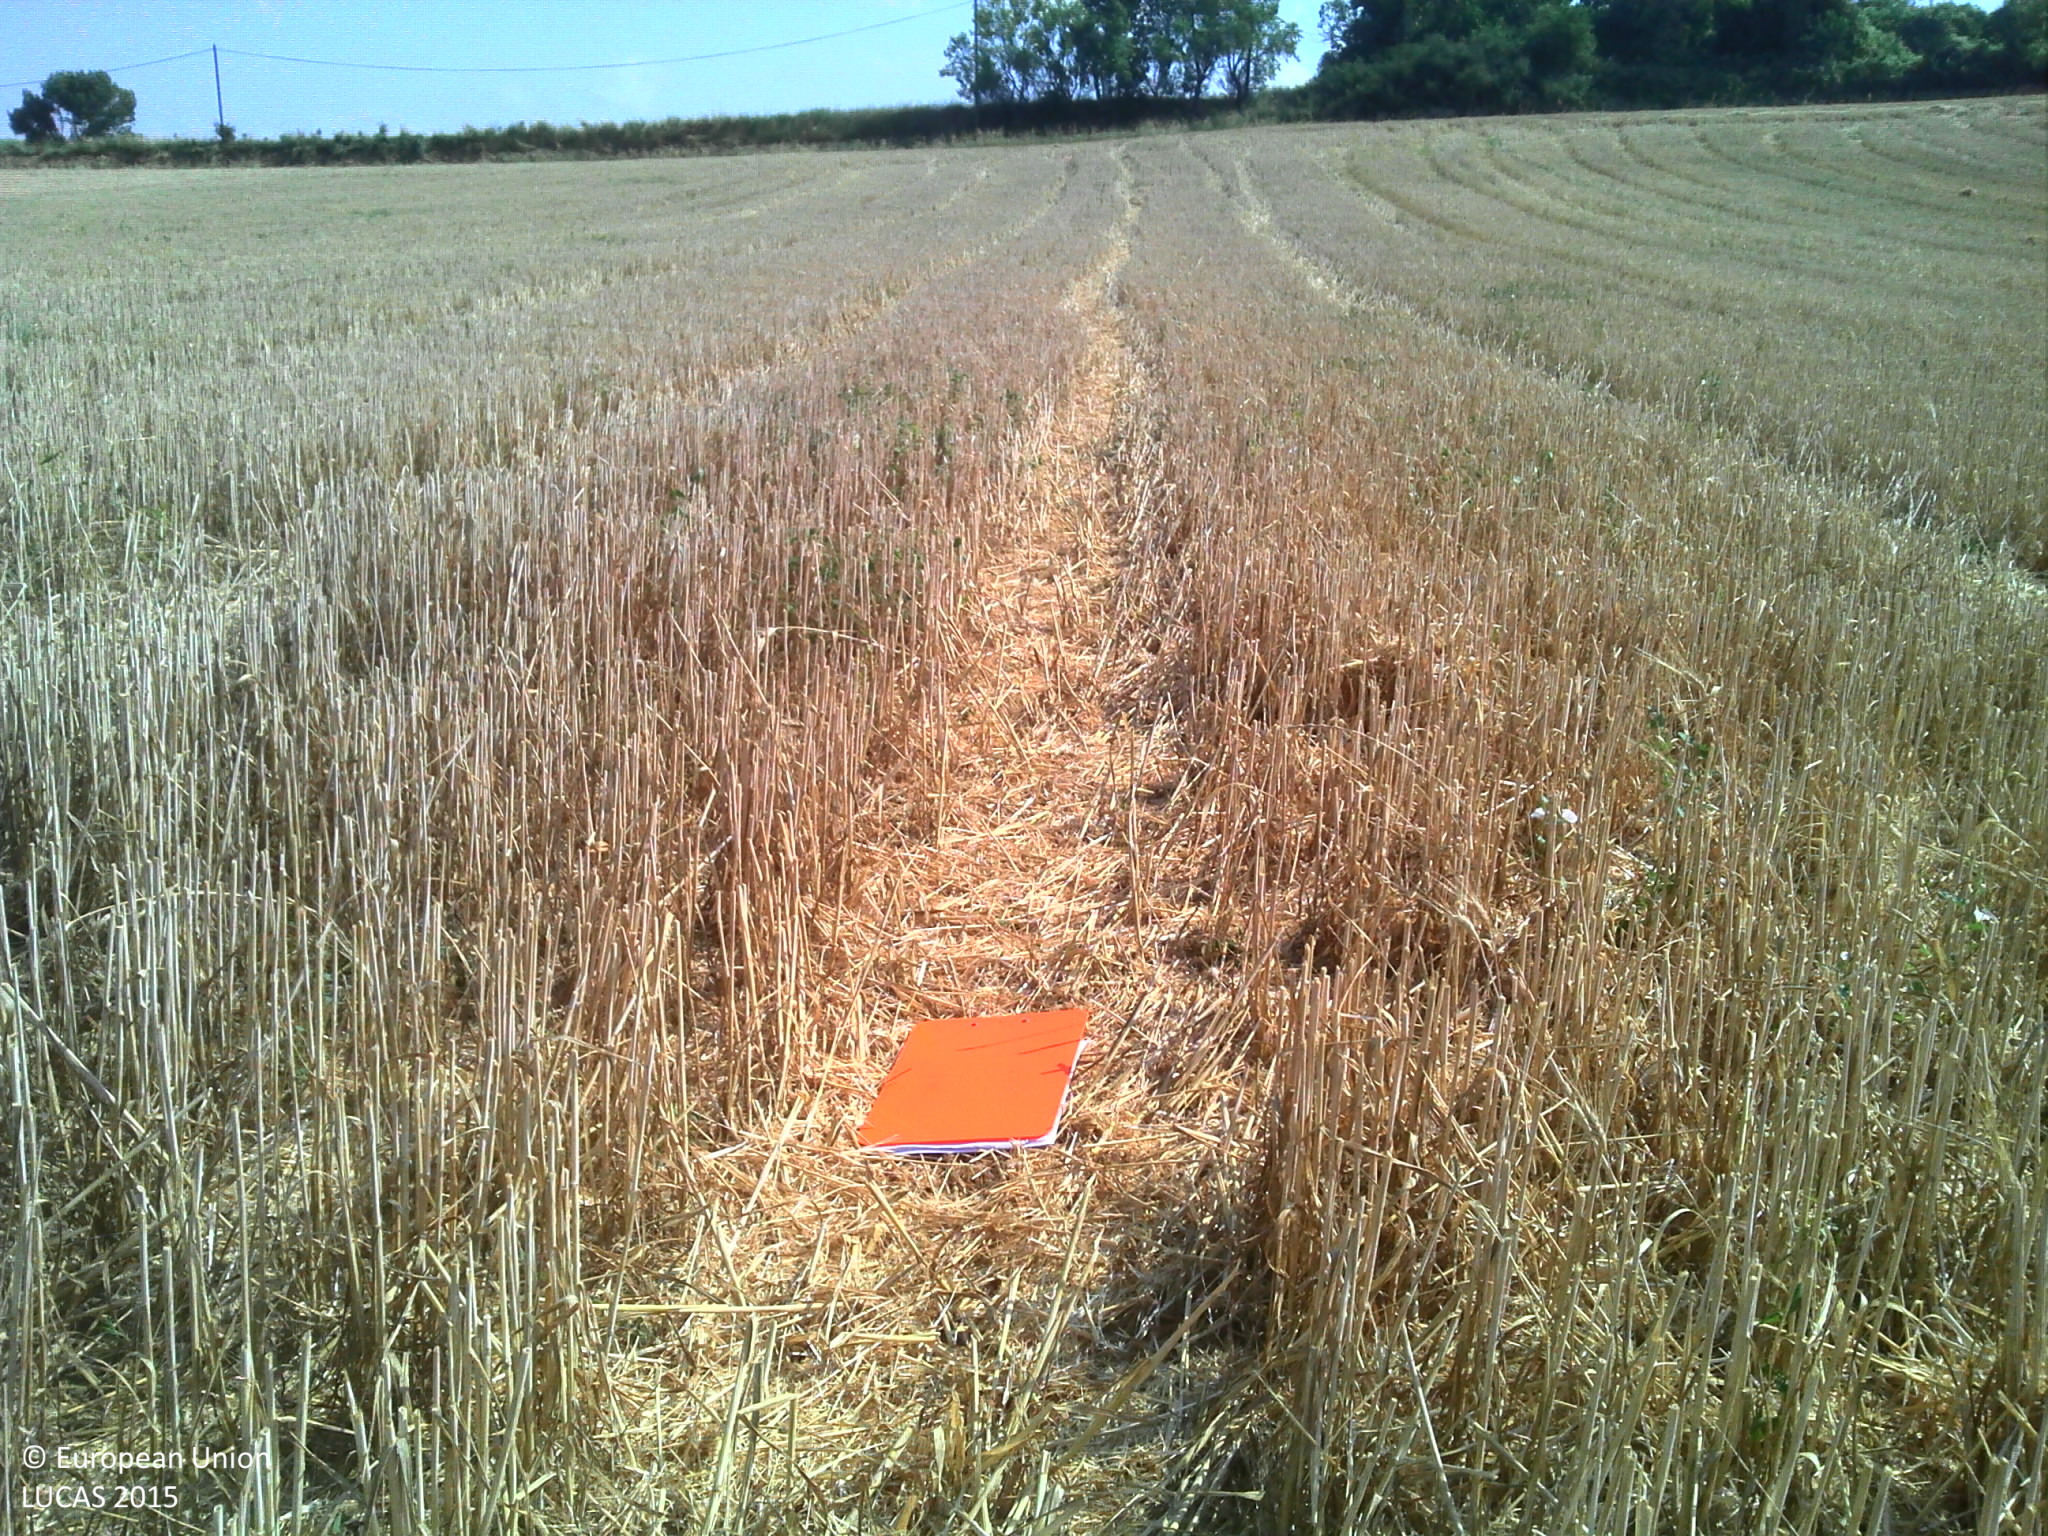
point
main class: Cropland
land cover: Durum wheat
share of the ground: > 75 %
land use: Agriculture (excluding fallow land and kitchen gardens)
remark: Harvested field
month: July
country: FR
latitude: 43.1412
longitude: 2.0774
